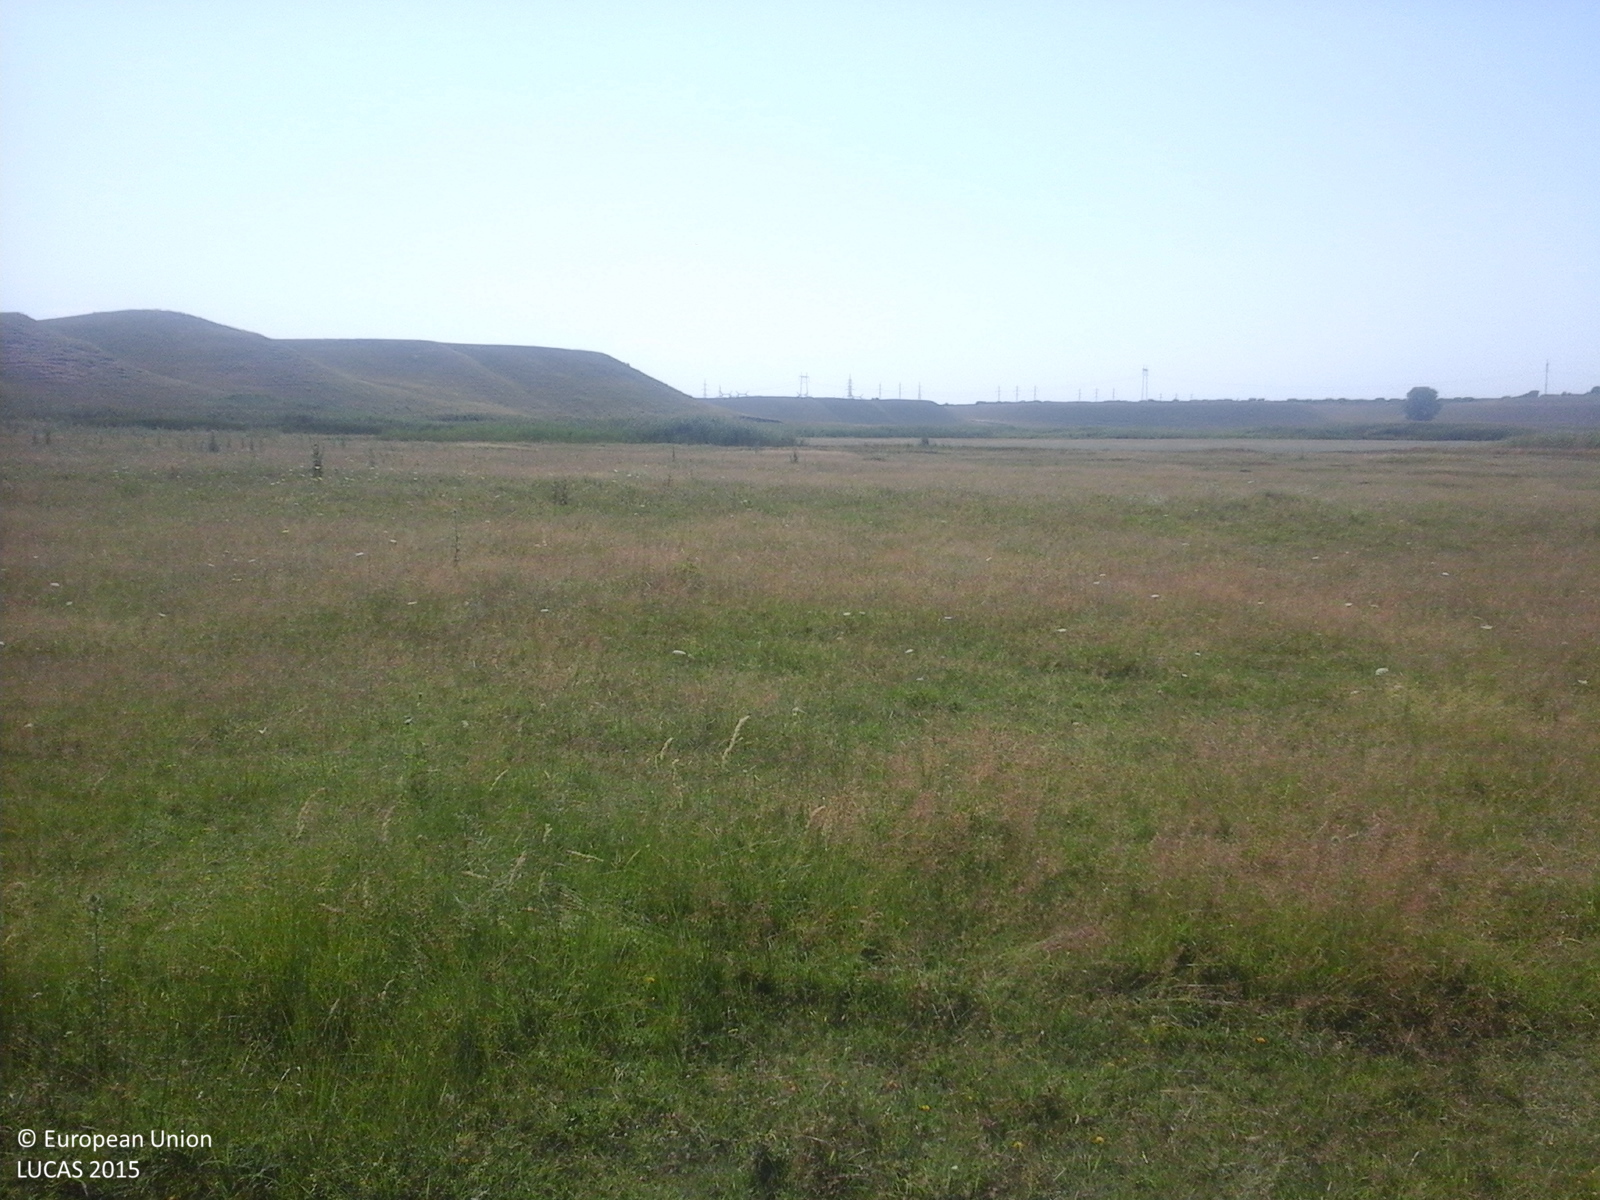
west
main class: Grassland
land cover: Grassland without tree/shrub cover
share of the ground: > 75 %
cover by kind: herbaceous plants 100 %
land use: Agriculture (excluding fallow land and kitchen gardens)
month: July
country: RO
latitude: 44.8938
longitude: 27.7166
